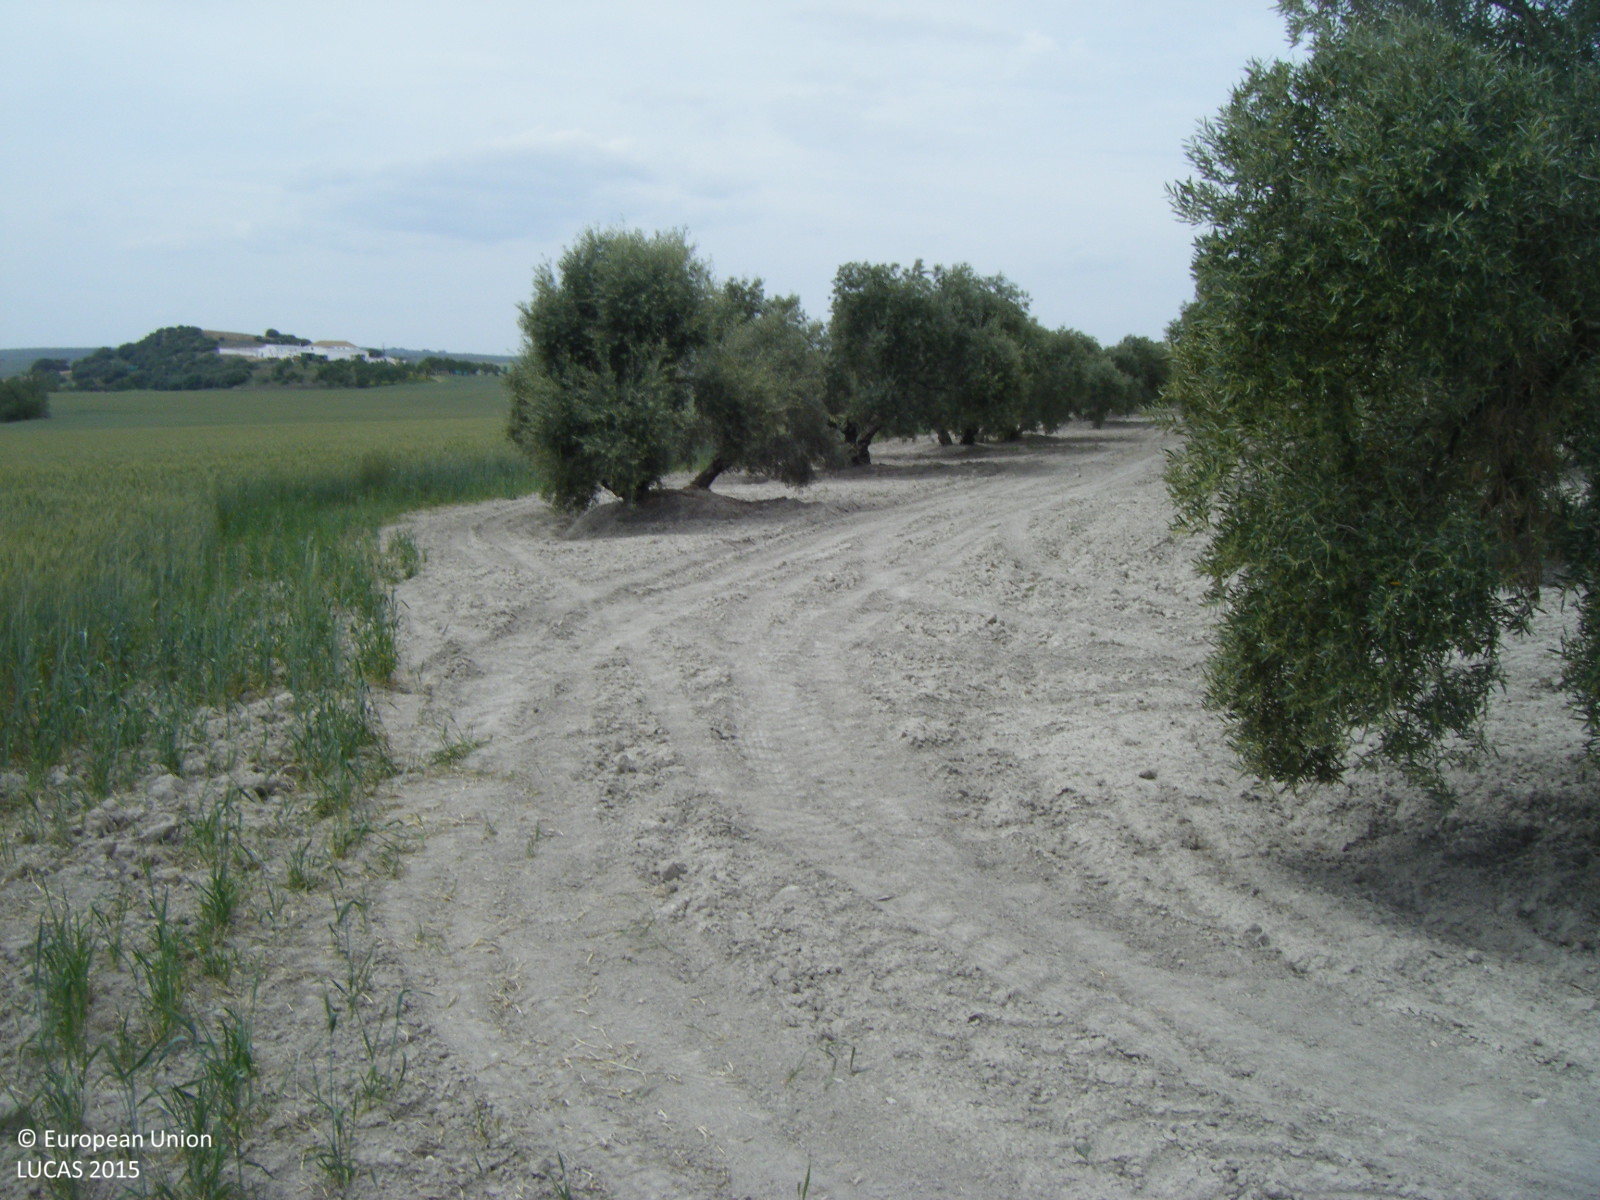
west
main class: Shrubland
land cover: Shrubland without tree cover
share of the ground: > 75 %
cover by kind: shrubs 80 %, herbaceous plants 20 %
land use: Semi-natural and natural areas not in use
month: April
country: ES
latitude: 37.1195
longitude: -4.7785
